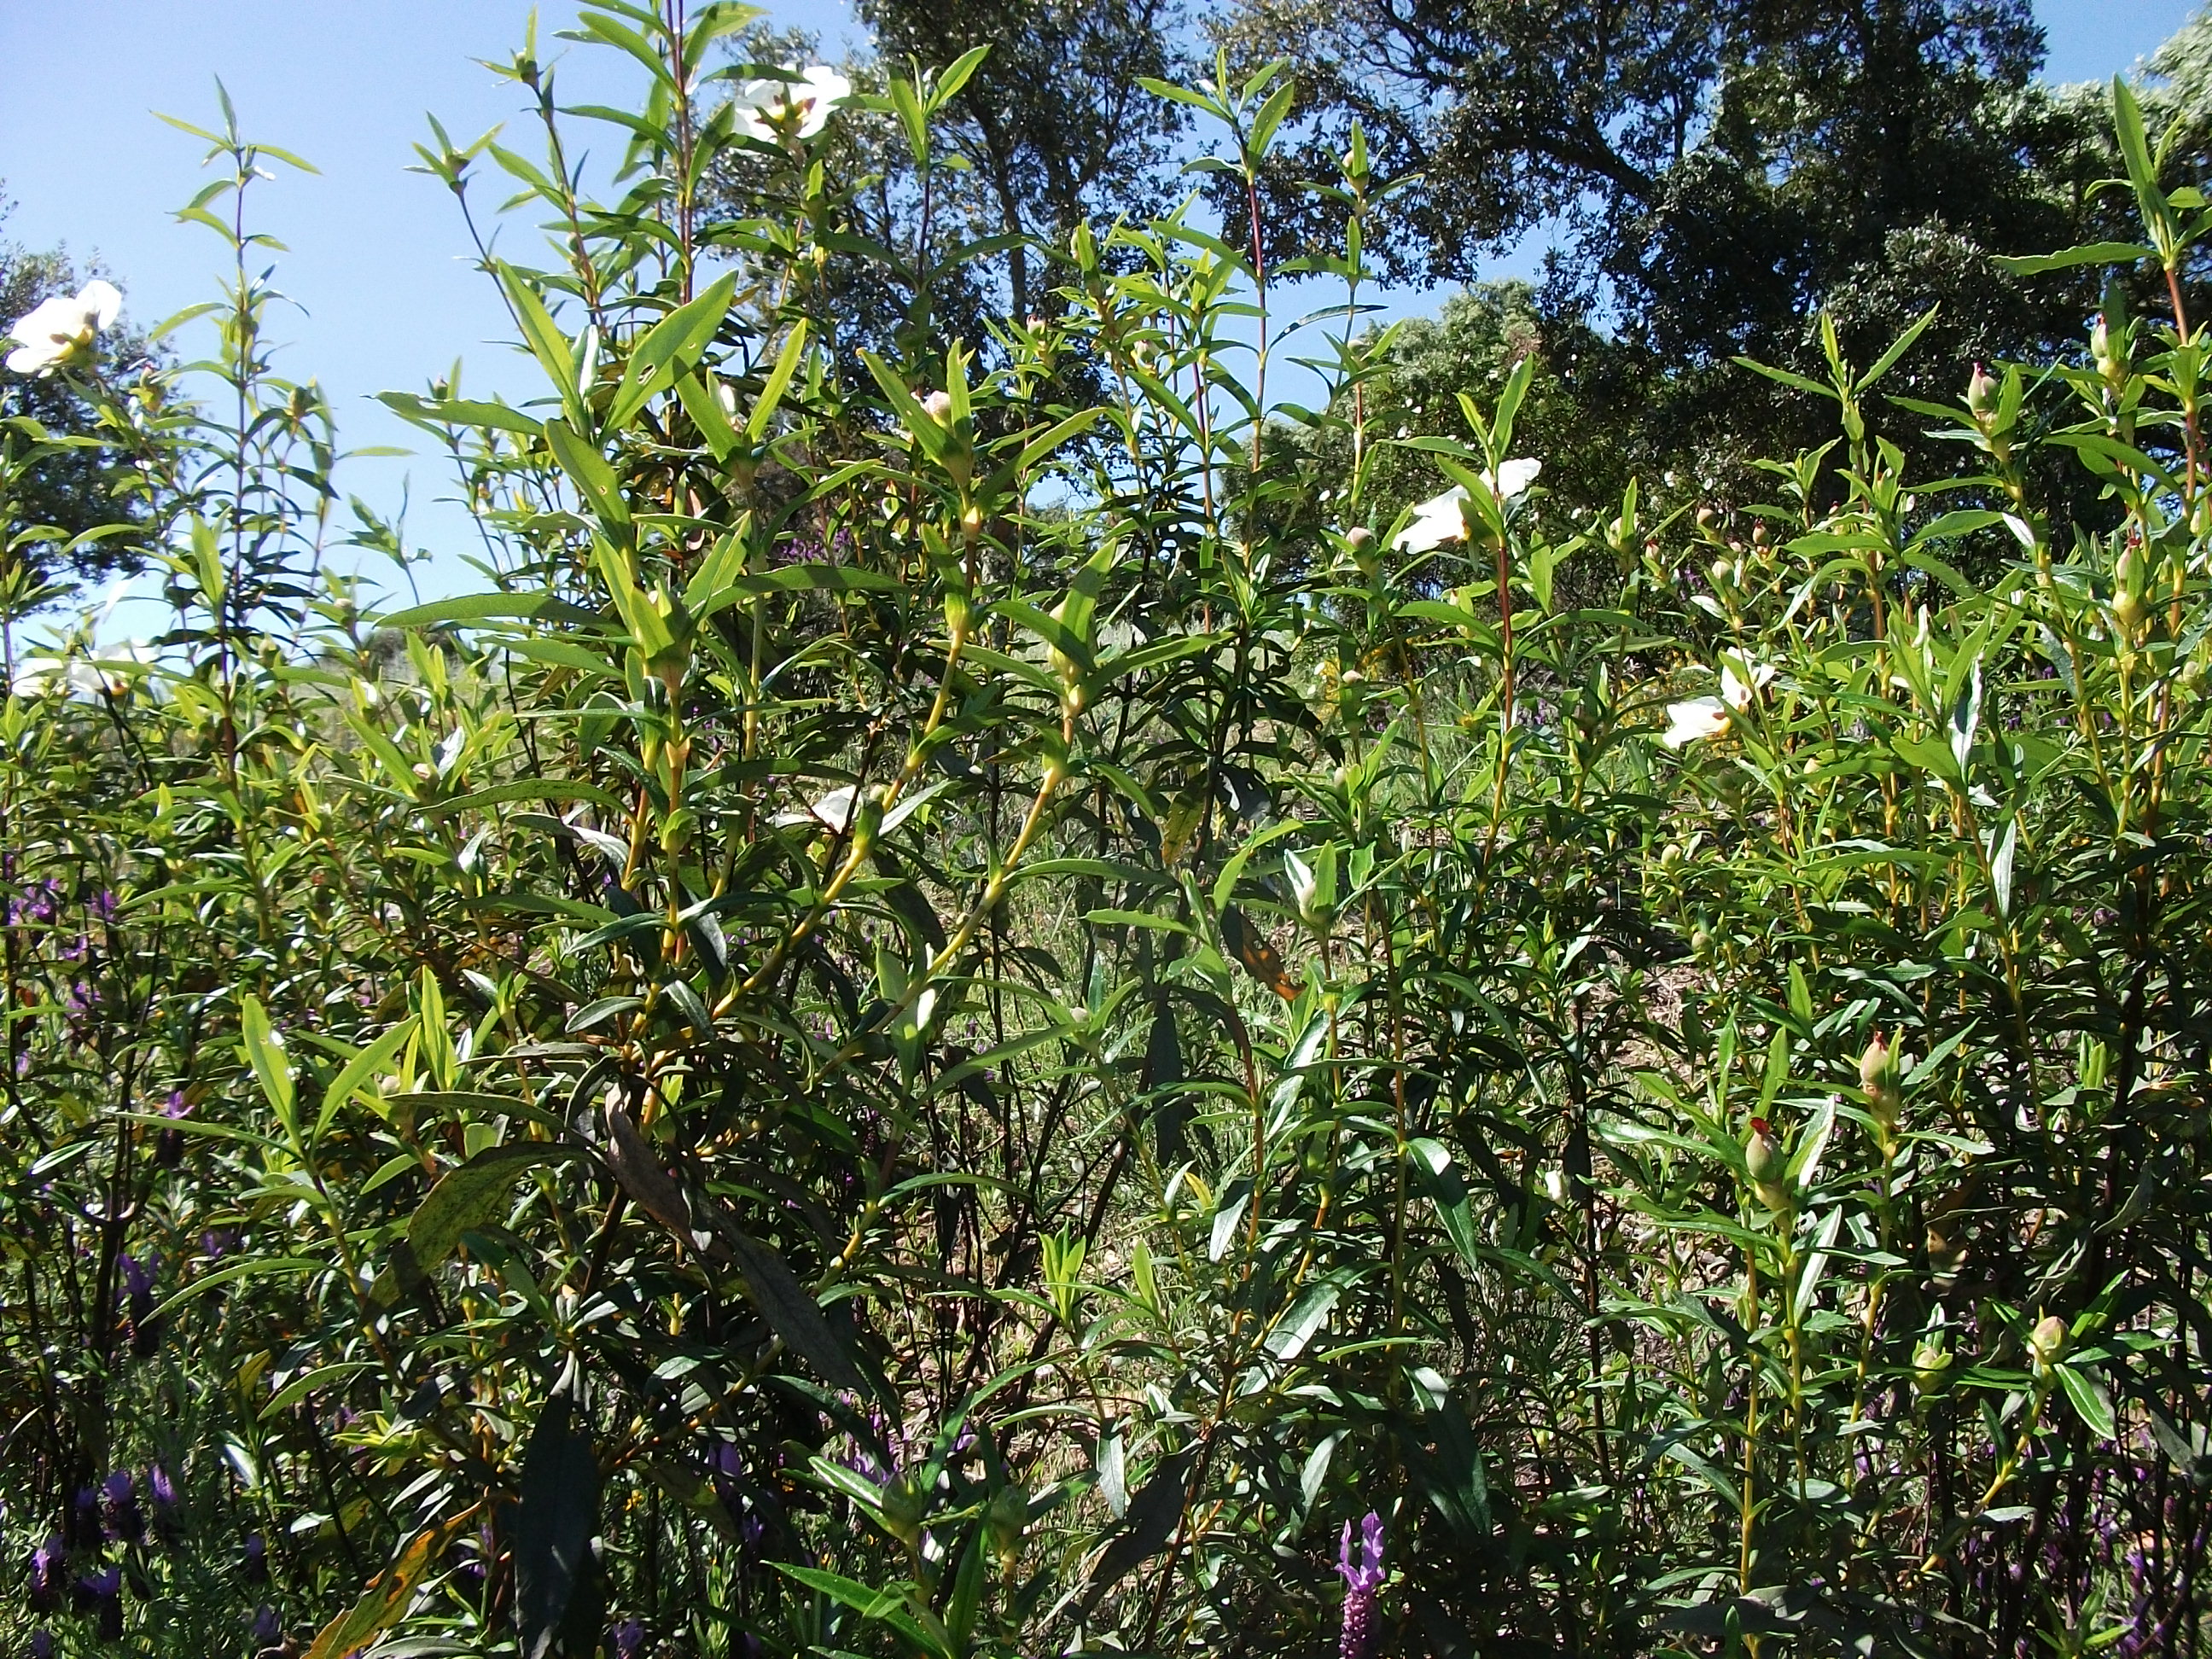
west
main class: Woodland
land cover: Broadleaved woodland
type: broadleaved evergreen forest
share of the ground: 50 - 75 %
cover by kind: broadleaved forest trees 70 %, shrubs 30 %
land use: Semi-natural and natural areas not in use
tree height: > 5 m
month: April
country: ES
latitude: 38.0138
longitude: -7.1075
